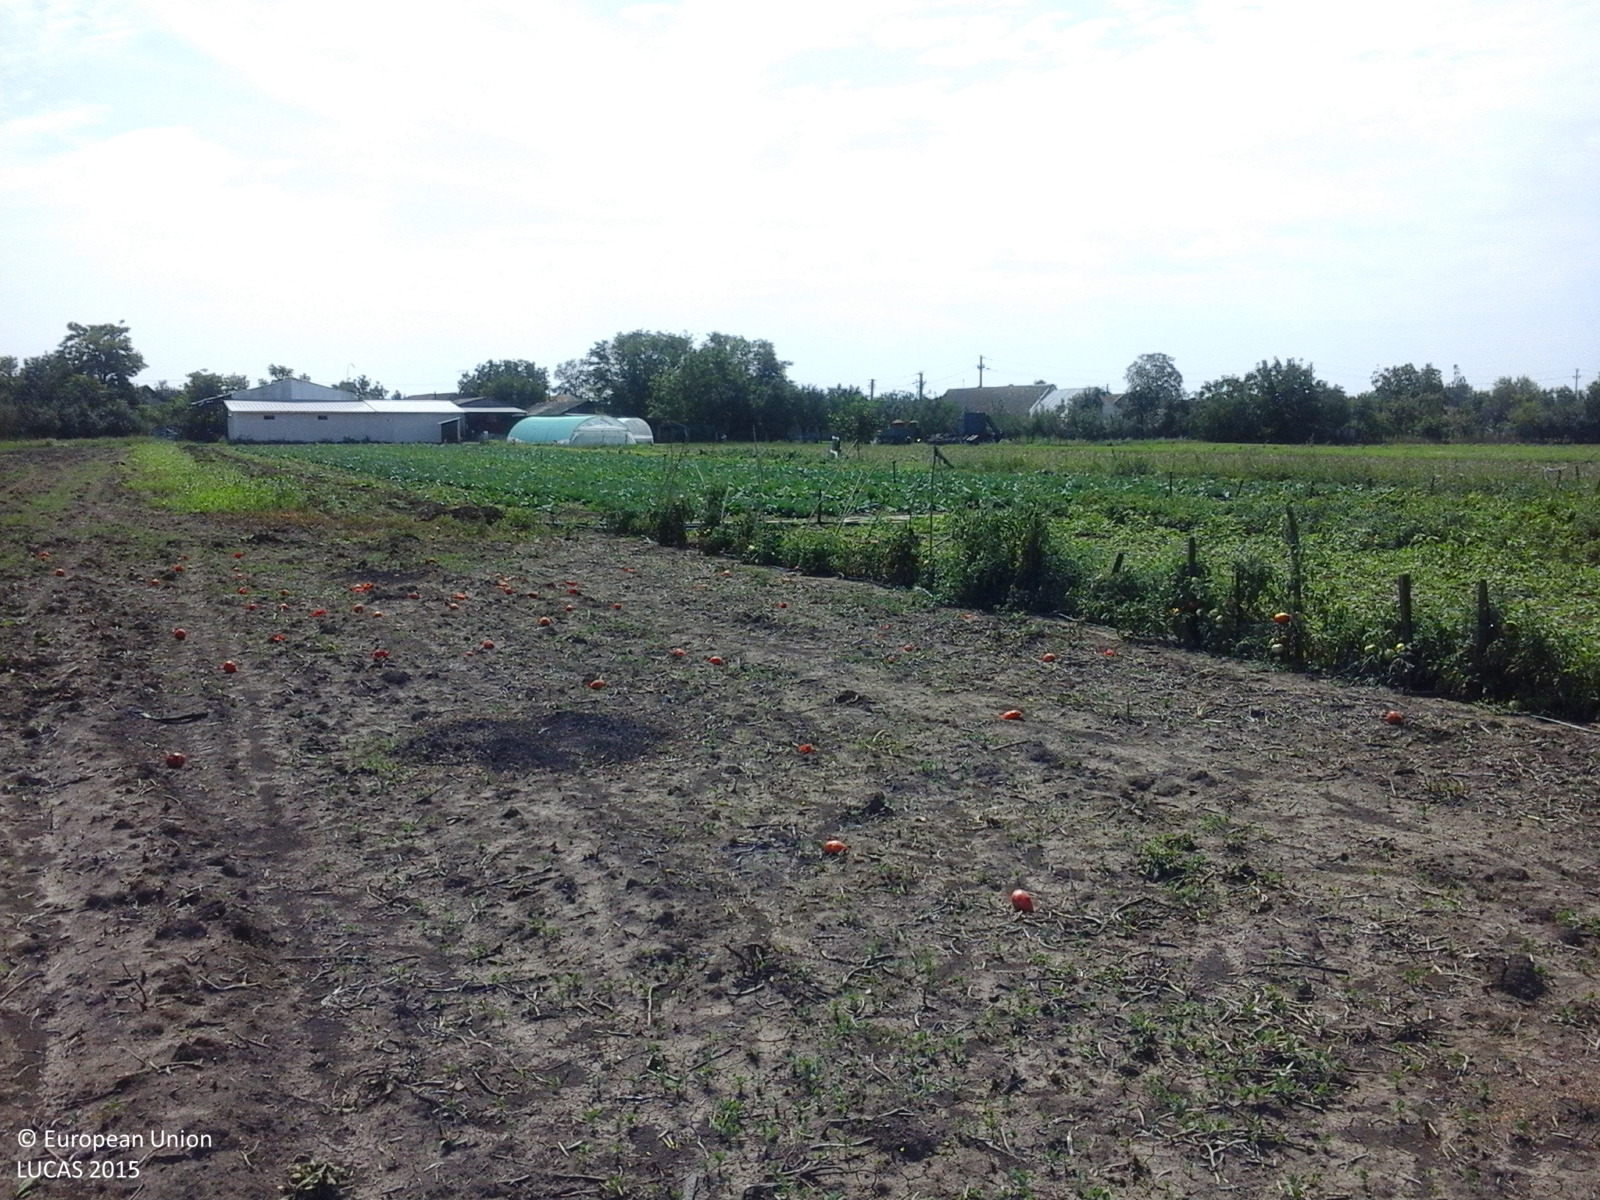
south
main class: Cropland
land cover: Tomatoes
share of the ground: < 10 %
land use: Agriculture (excluding fallow land and kitchen gardens)
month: August
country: RO
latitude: 46.1762
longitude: 21.0544
